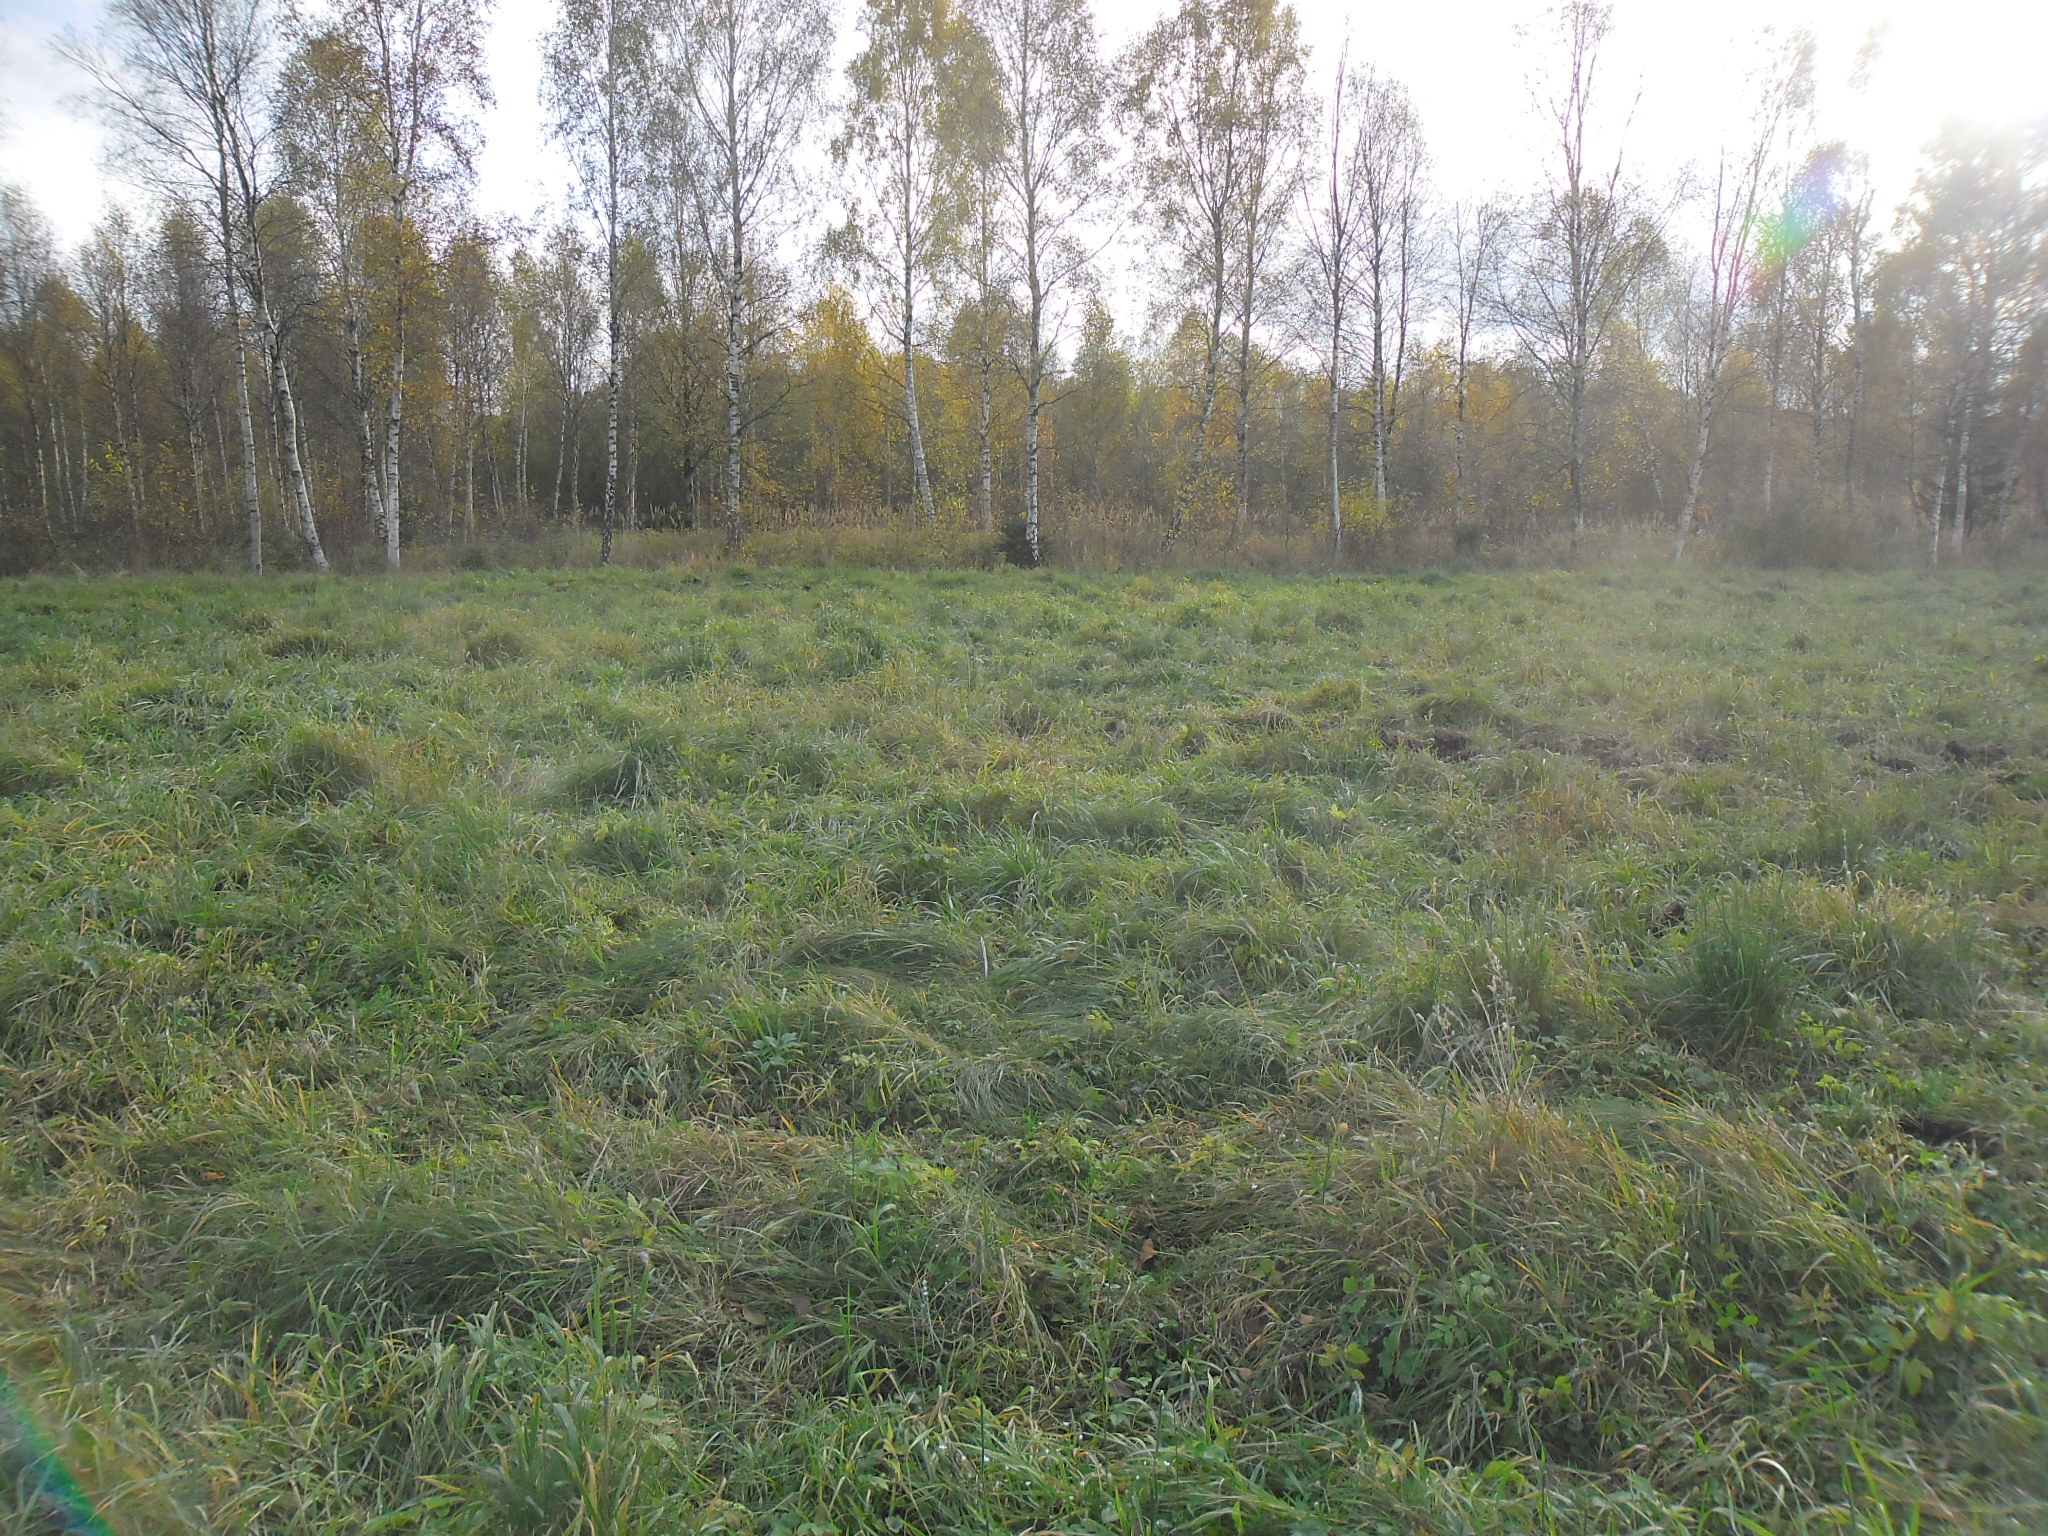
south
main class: Grassland
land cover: Grassland without tree/shrub cover
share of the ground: > 75 %
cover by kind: herbaceous plants 100 %
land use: Agriculture (excluding fallow land and kitchen gardens)
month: October
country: SE
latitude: 56.0613
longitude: 13.7397
